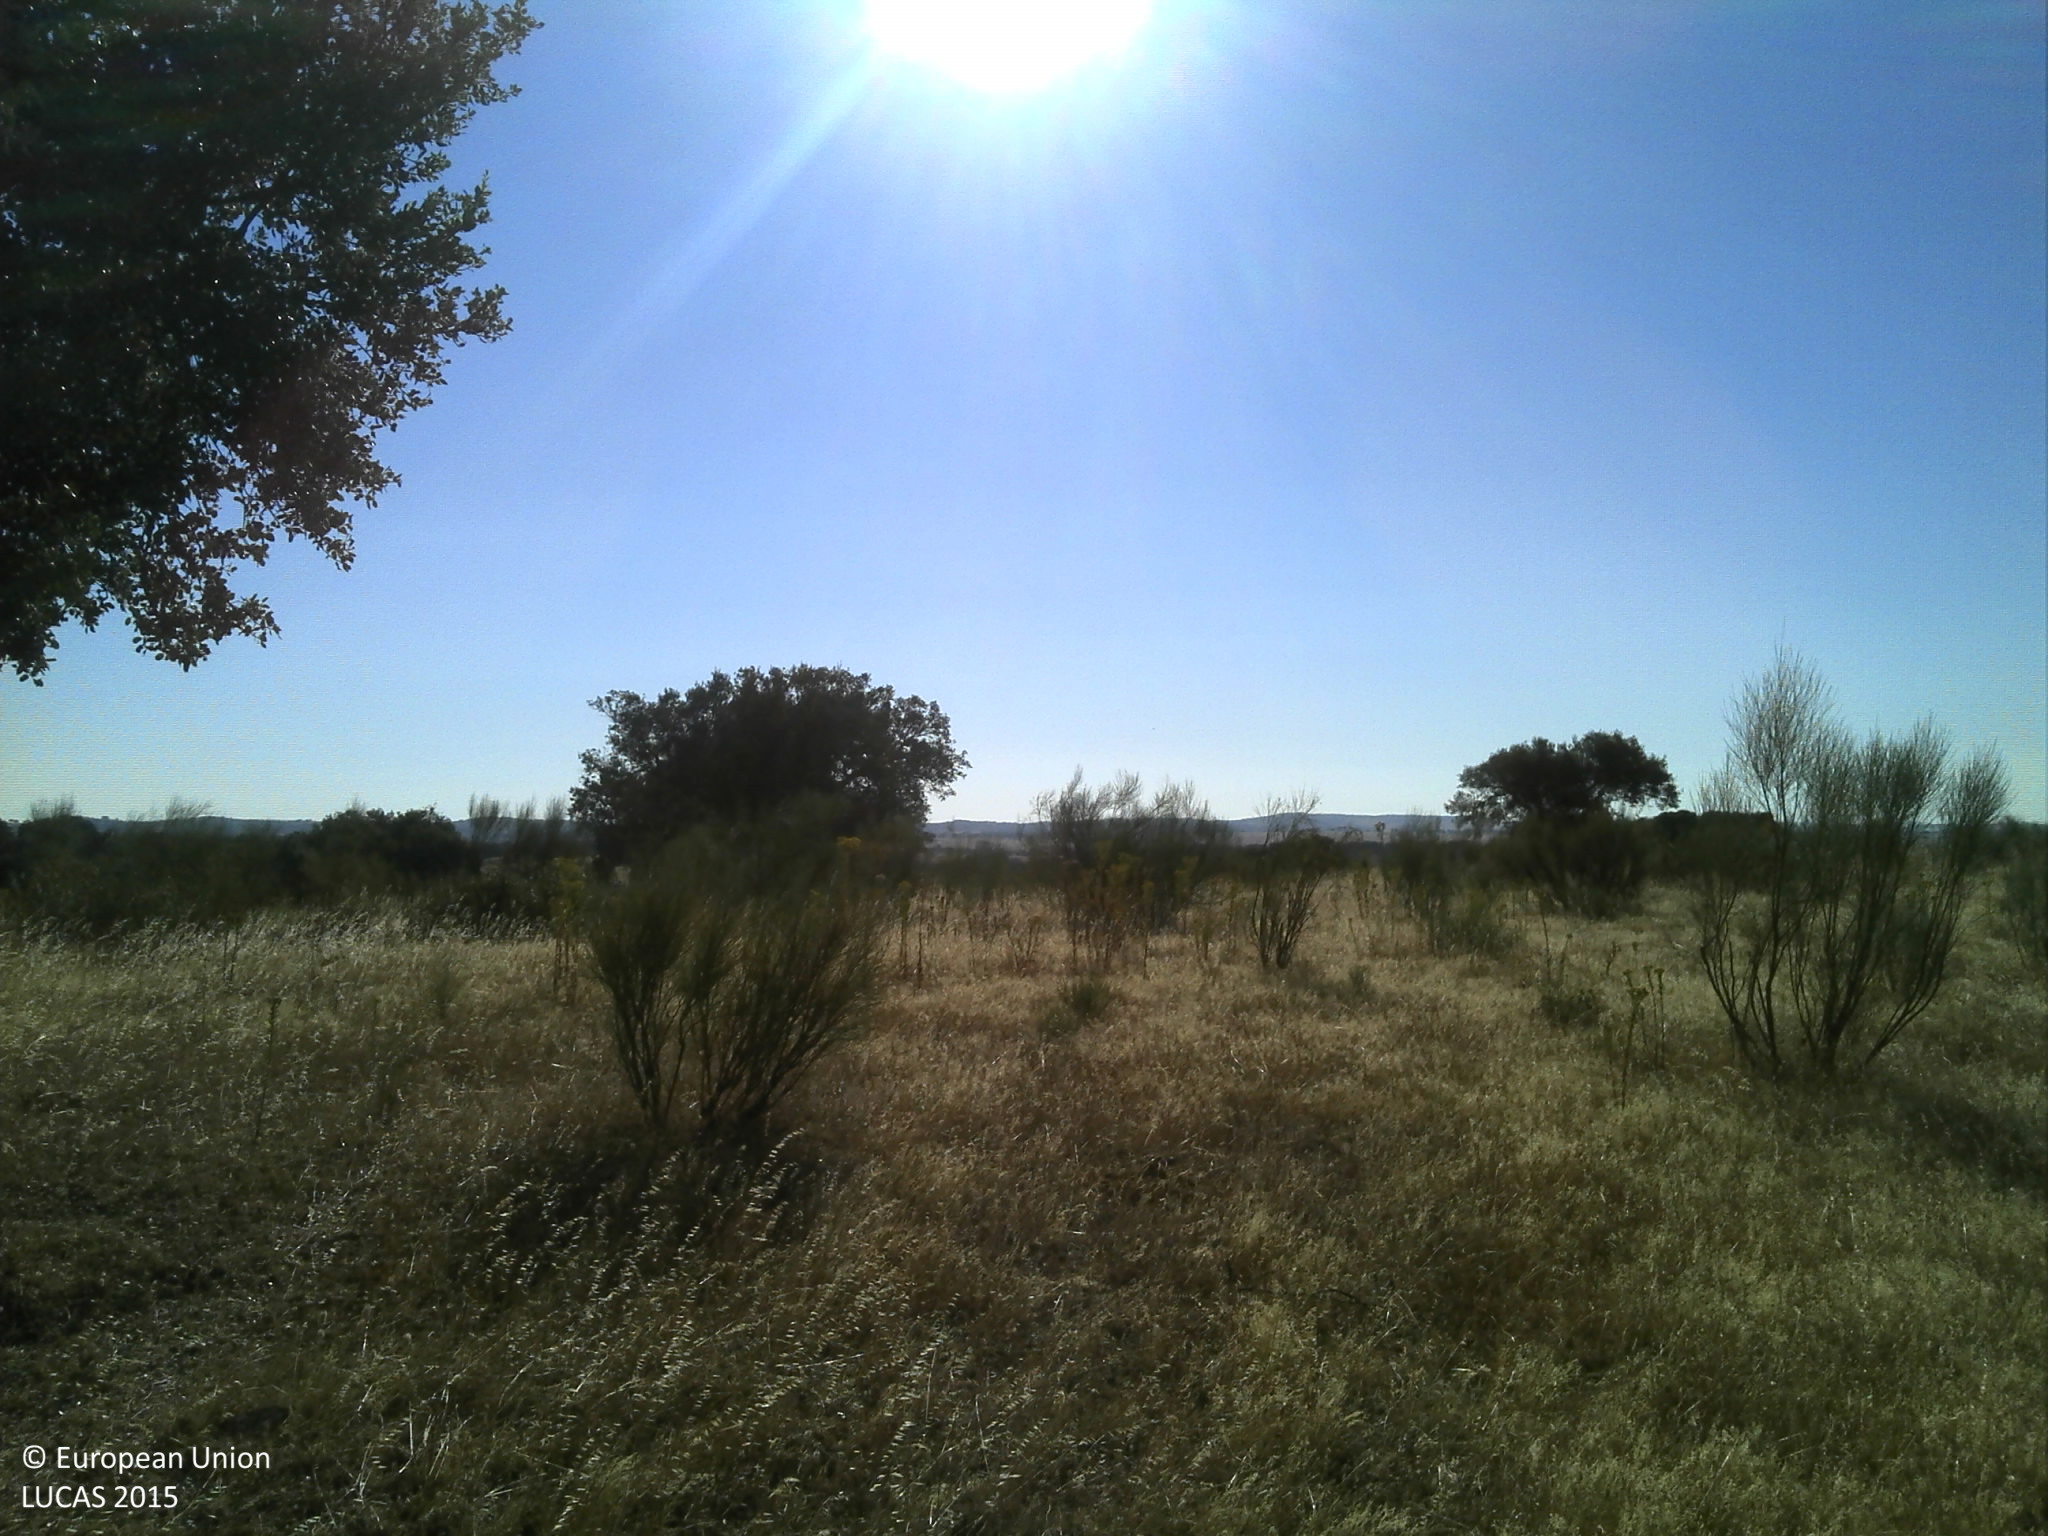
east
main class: Grassland
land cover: Grassland with sparse tree/shrub cover
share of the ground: > 75 %
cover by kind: herbaceous plants 80 %, shrubs 10 %, broadleaved forest trees 5 %, unconsolidated bare surface 5 %
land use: Agriculture (excluding fallow land and kitchen gardens)
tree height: > 5 m
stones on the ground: < 10 %
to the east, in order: Grassland with sparse tree/shrub cover; Grassland without tree/shrub cover
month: July
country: PT
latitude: 38.9147
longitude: -7.5323
